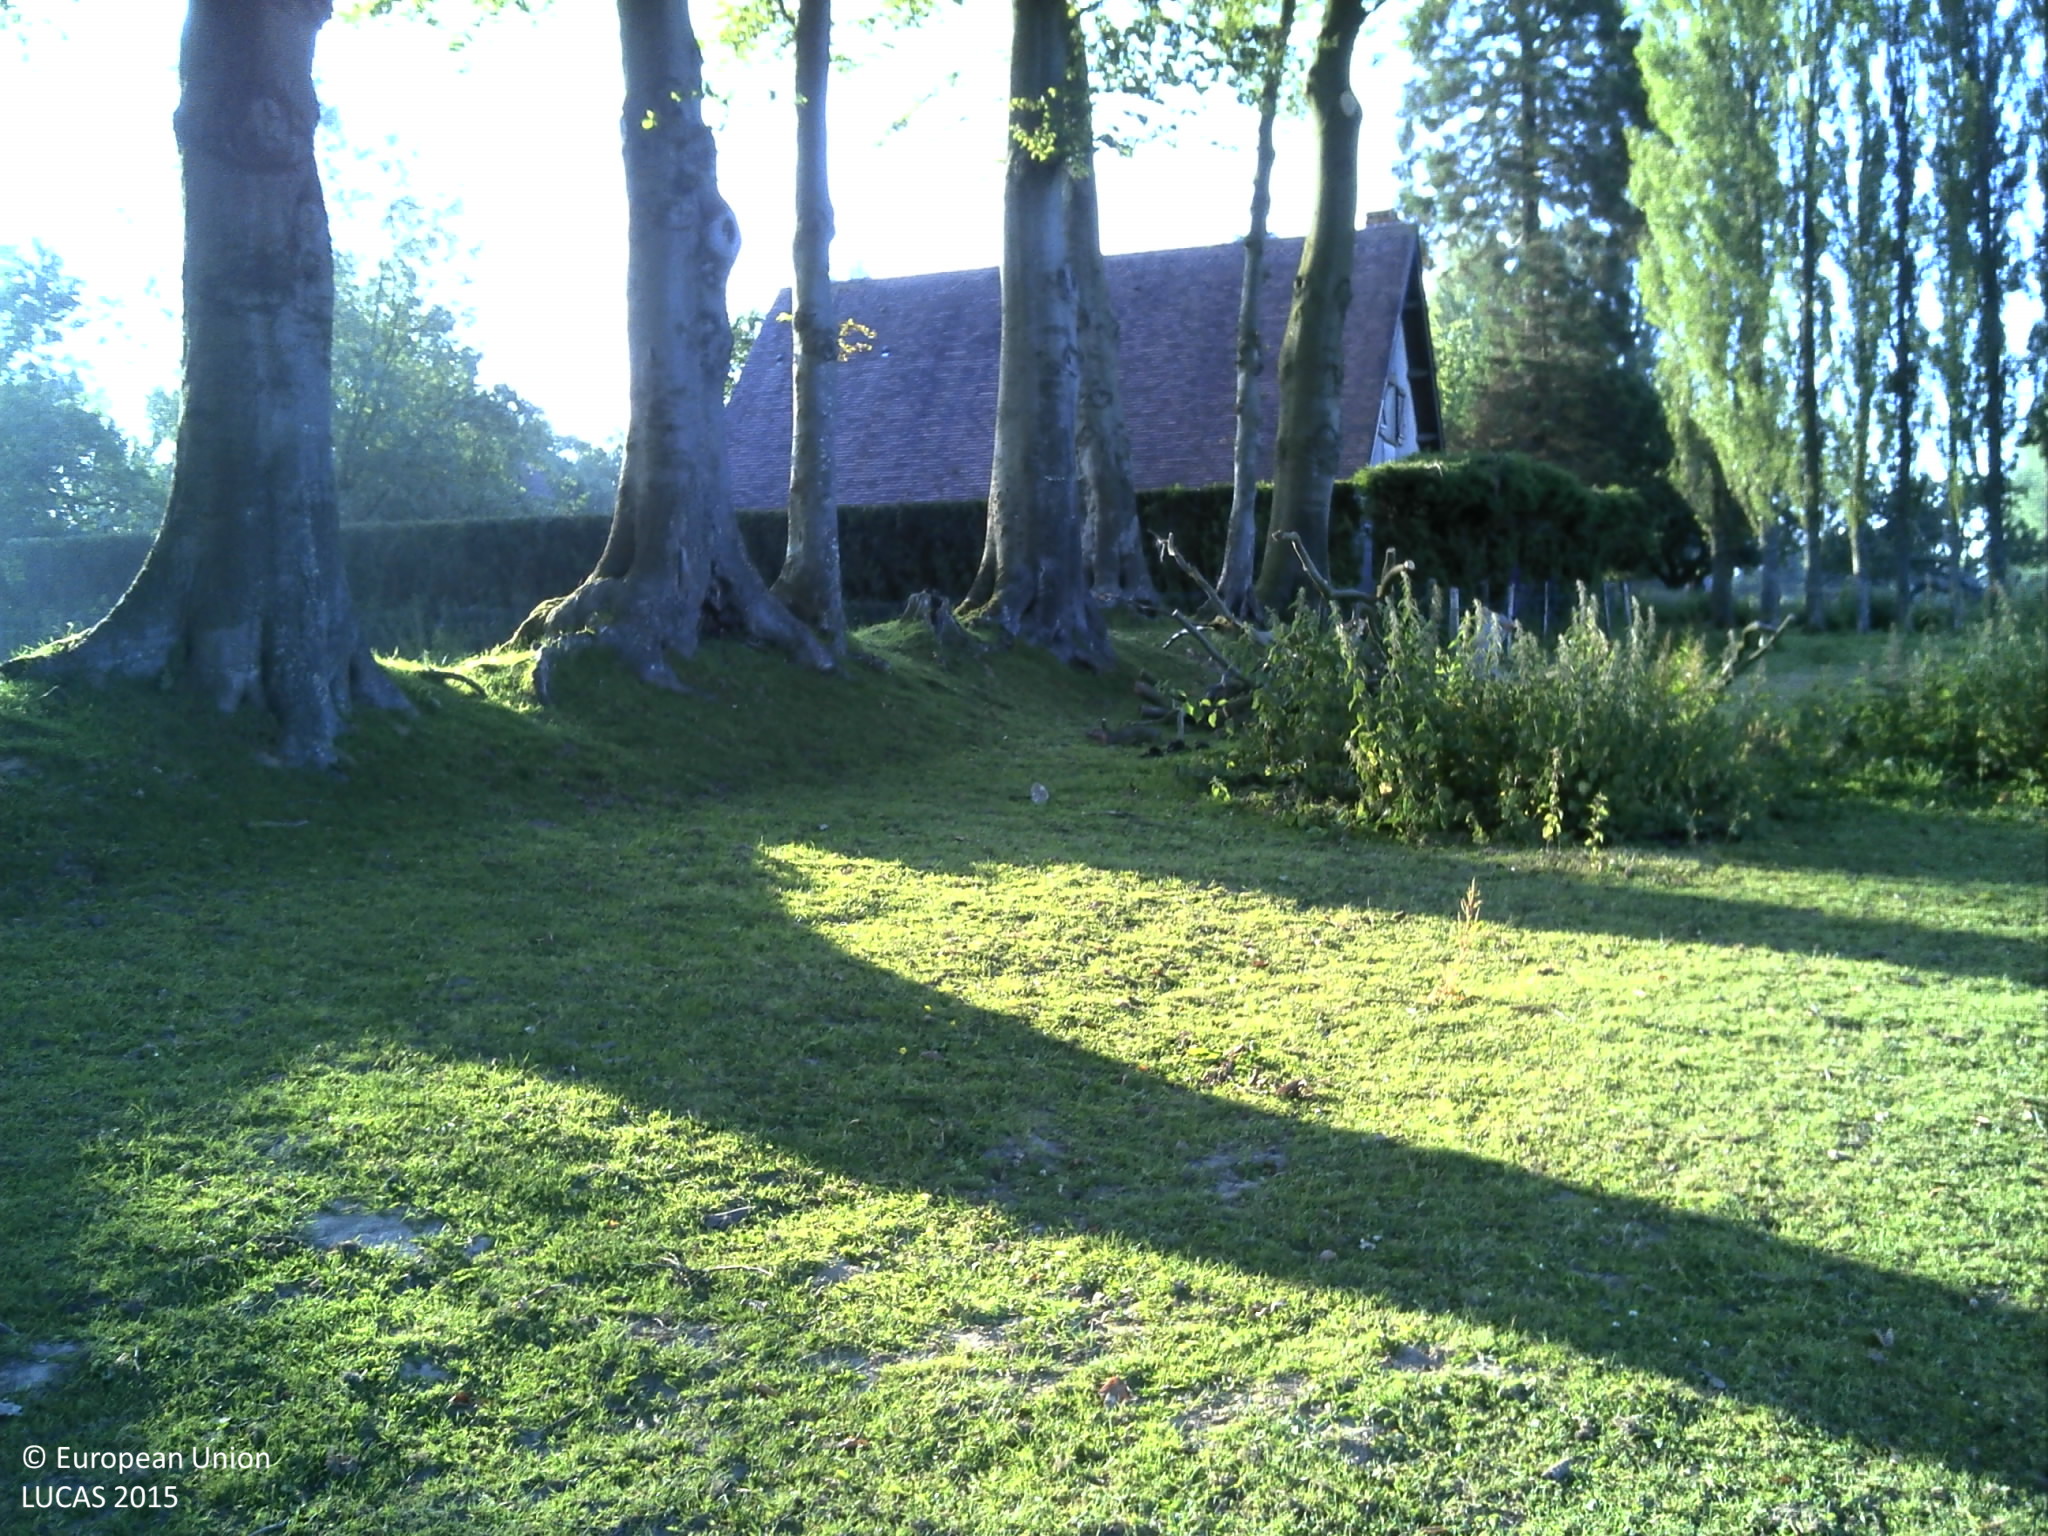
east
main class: Grassland
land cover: Grassland without tree/shrub cover
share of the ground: > 75 %
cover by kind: herbaceous plants 100 %
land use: Agriculture (excluding fallow land and kitchen gardens)
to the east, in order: Grassland without tree/shrub cover; Lines of trees; Grassland with sparse tree/shrub cover; Artificial constructions in urban areas; Rape and turnip rape; Fences; Sugar beet
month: June
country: FR
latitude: 49.5602
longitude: 0.3915
